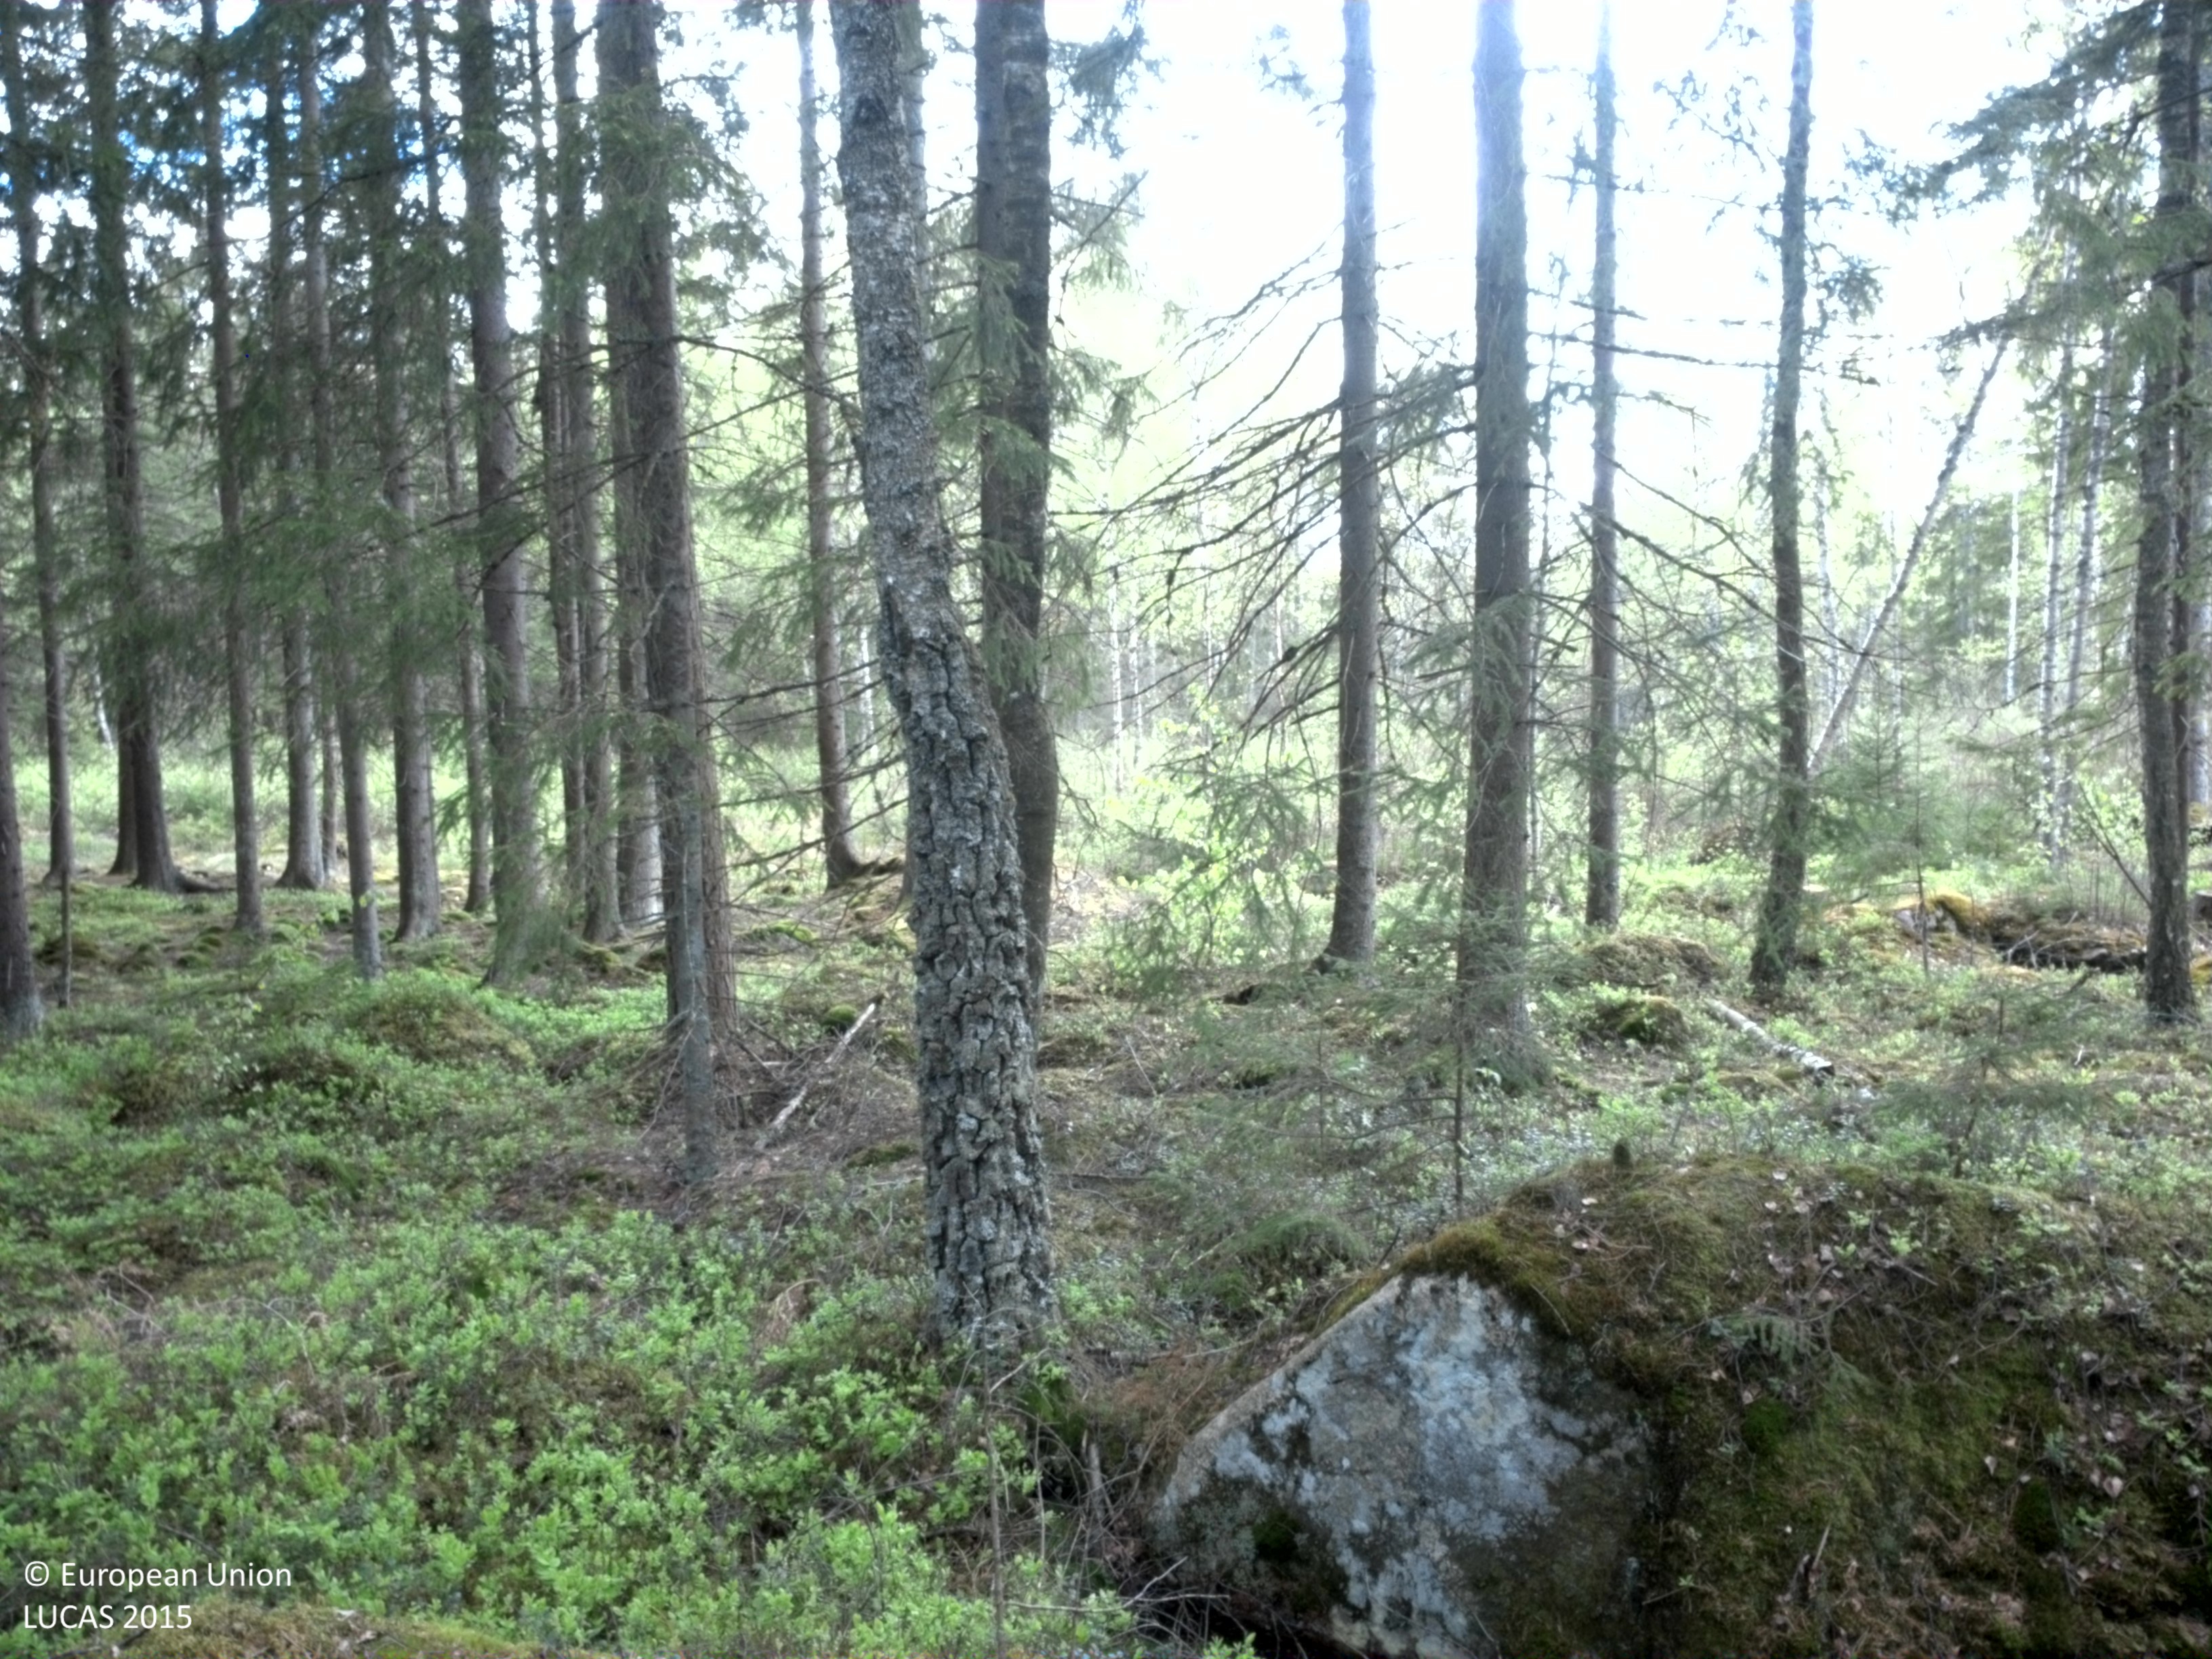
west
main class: Woodland
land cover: Spruce dominated coniferous woodland
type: boreal forest
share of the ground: 50 - 75 %
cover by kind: coniferous forest trees 60 %, lichens and mosses 30 %, broadleaved forest trees 10 %
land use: Forestry
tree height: > 5 m
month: May
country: SE
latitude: 56.6318
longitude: 14.4803
